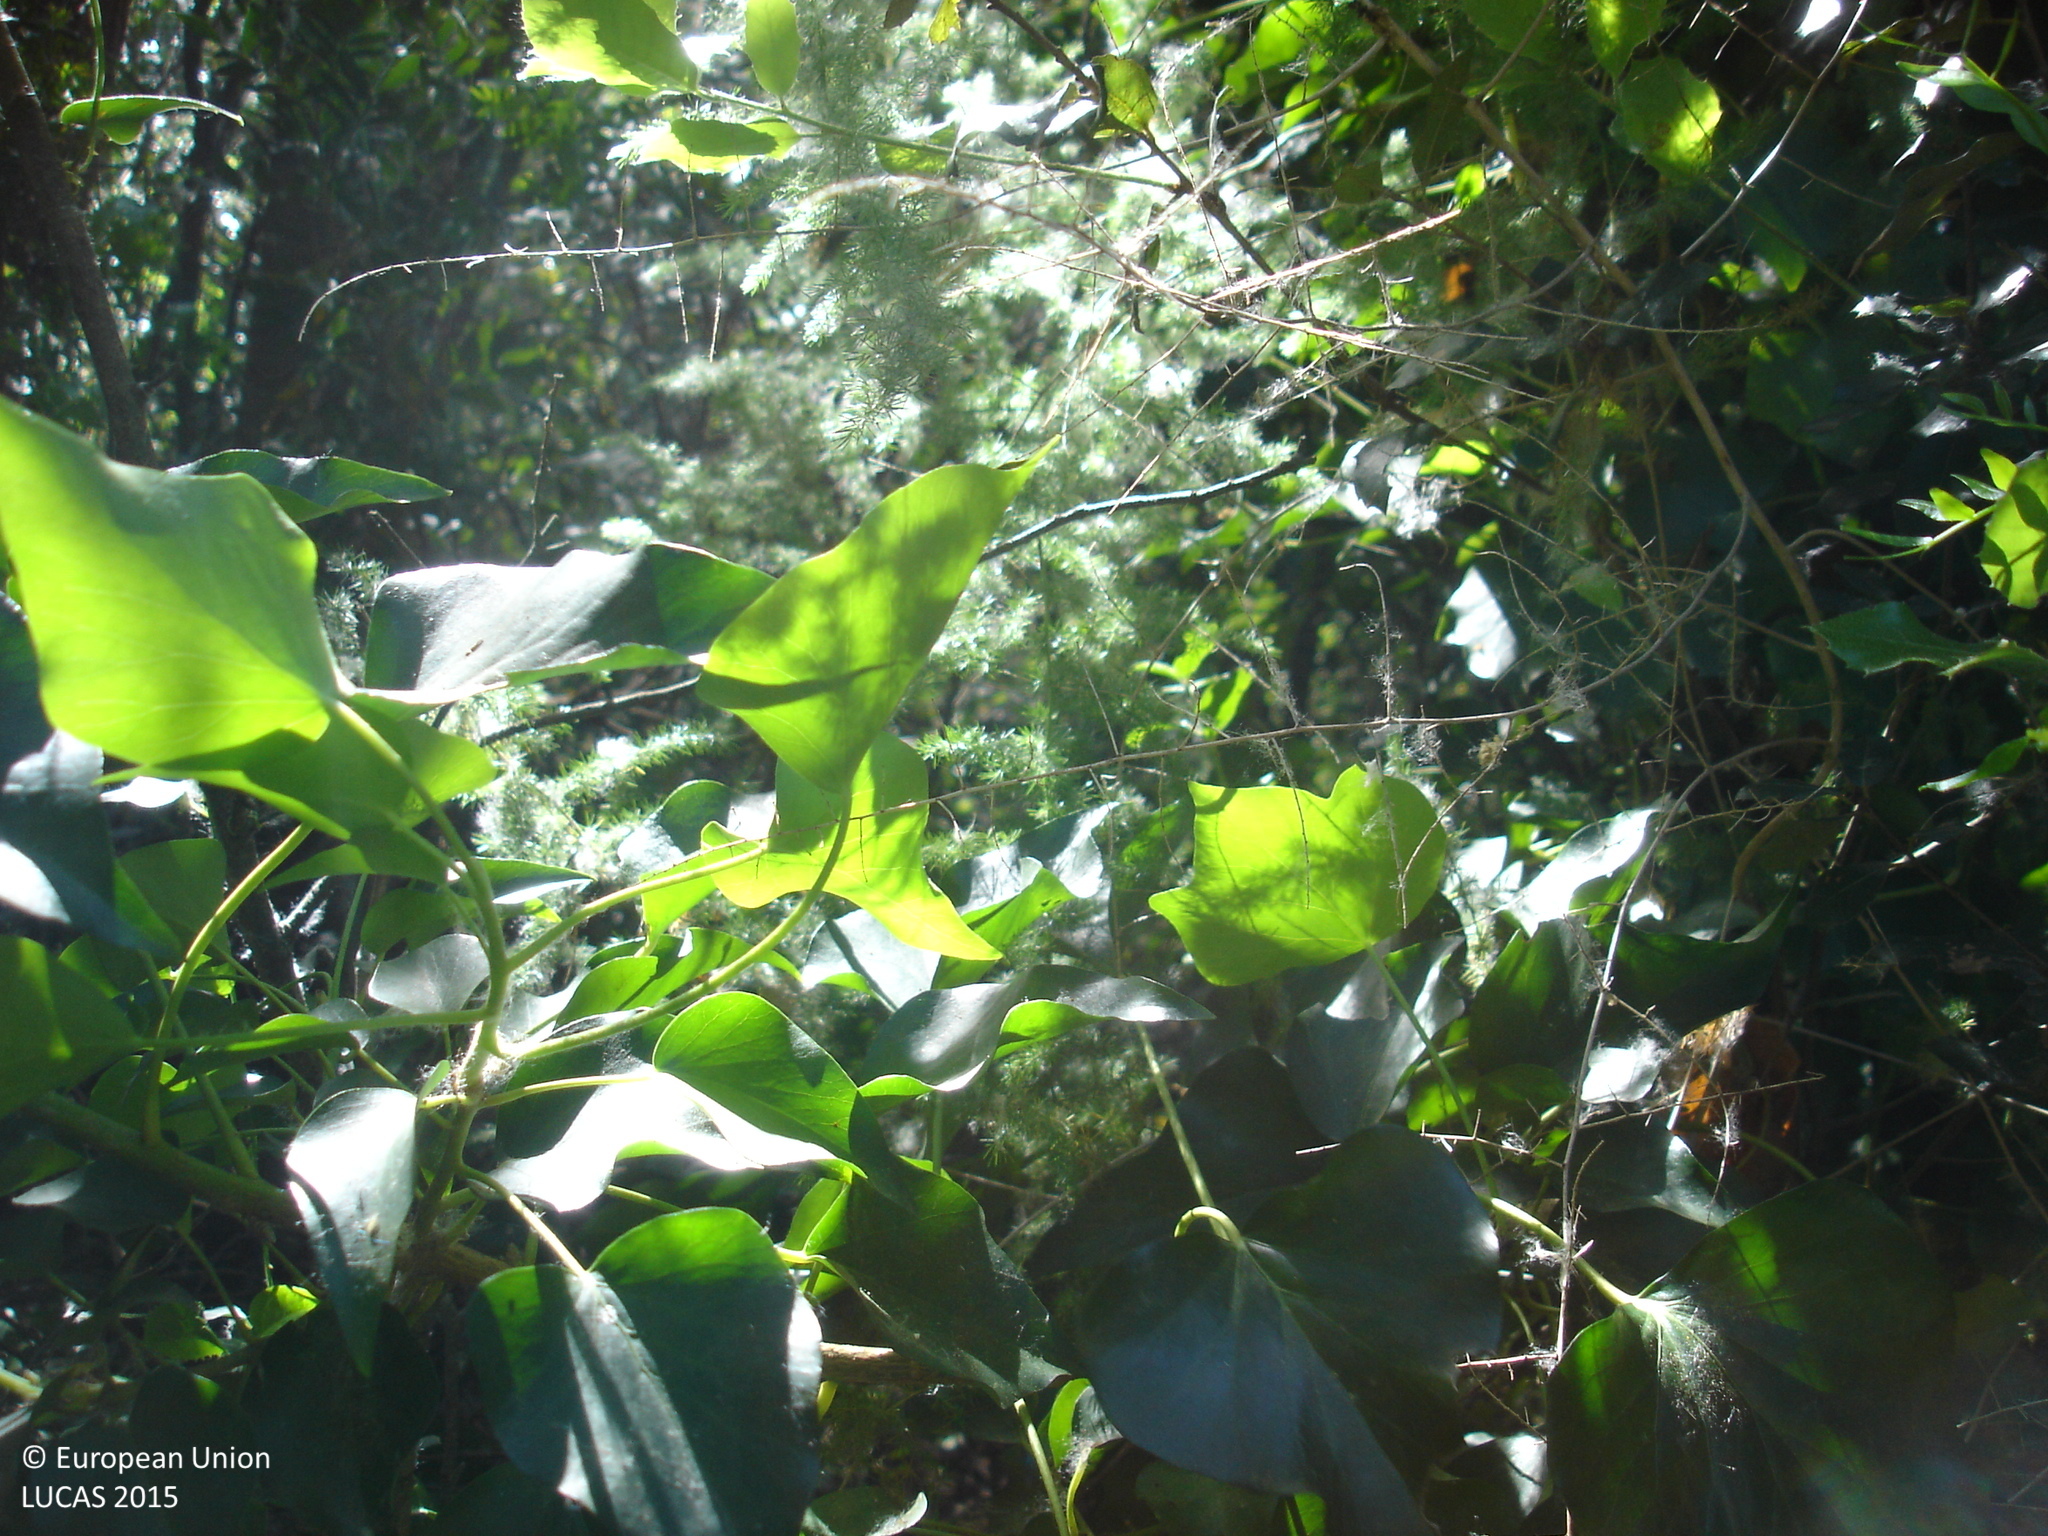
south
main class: Woodland
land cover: Broadleaved woodland
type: thermophilous deciduous forest
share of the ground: > 75 %
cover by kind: broadleaved forest trees 90 %, shrubs 10 %
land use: Forestry
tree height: > 5 m
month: May
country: ES
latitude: 42.1568
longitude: 2.9832
